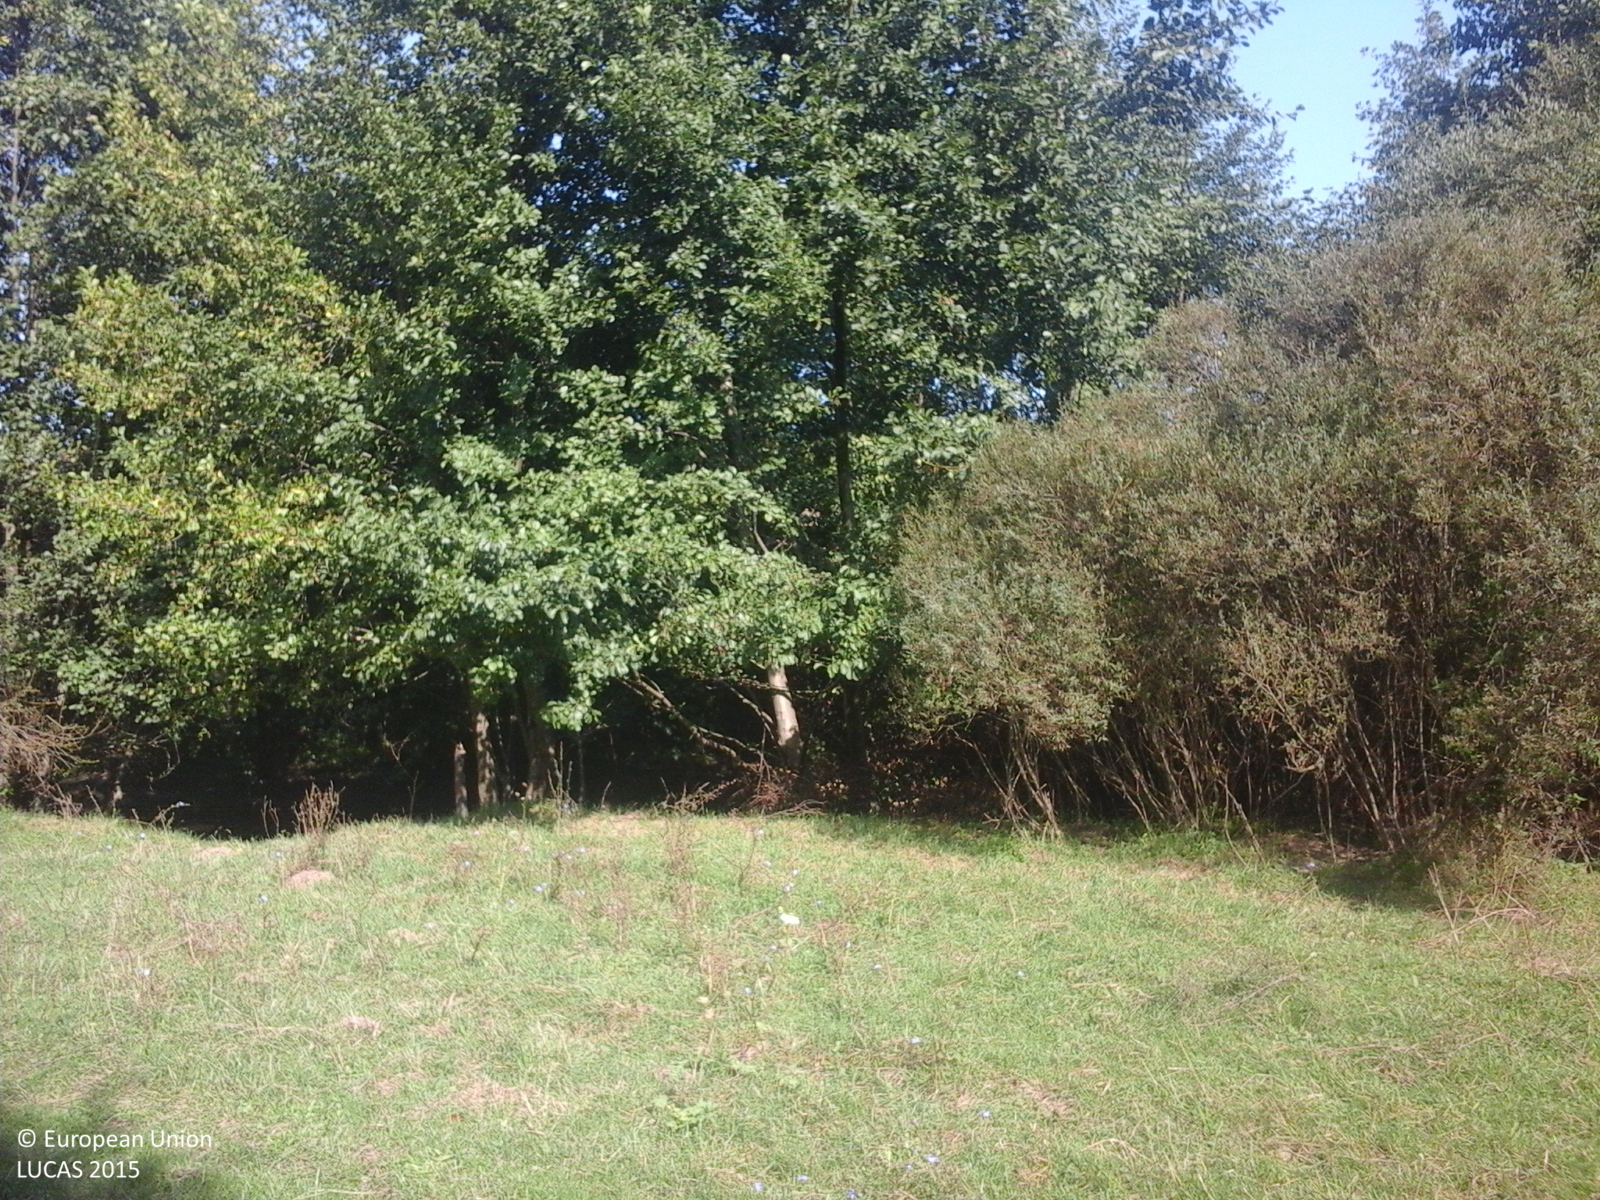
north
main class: Grassland
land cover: Grassland without tree/shrub cover
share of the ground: > 75 %
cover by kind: herbaceous plants 100 %
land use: Agriculture (excluding fallow land and kitchen gardens)
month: September
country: RO
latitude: 47.1390
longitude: 22.7029
